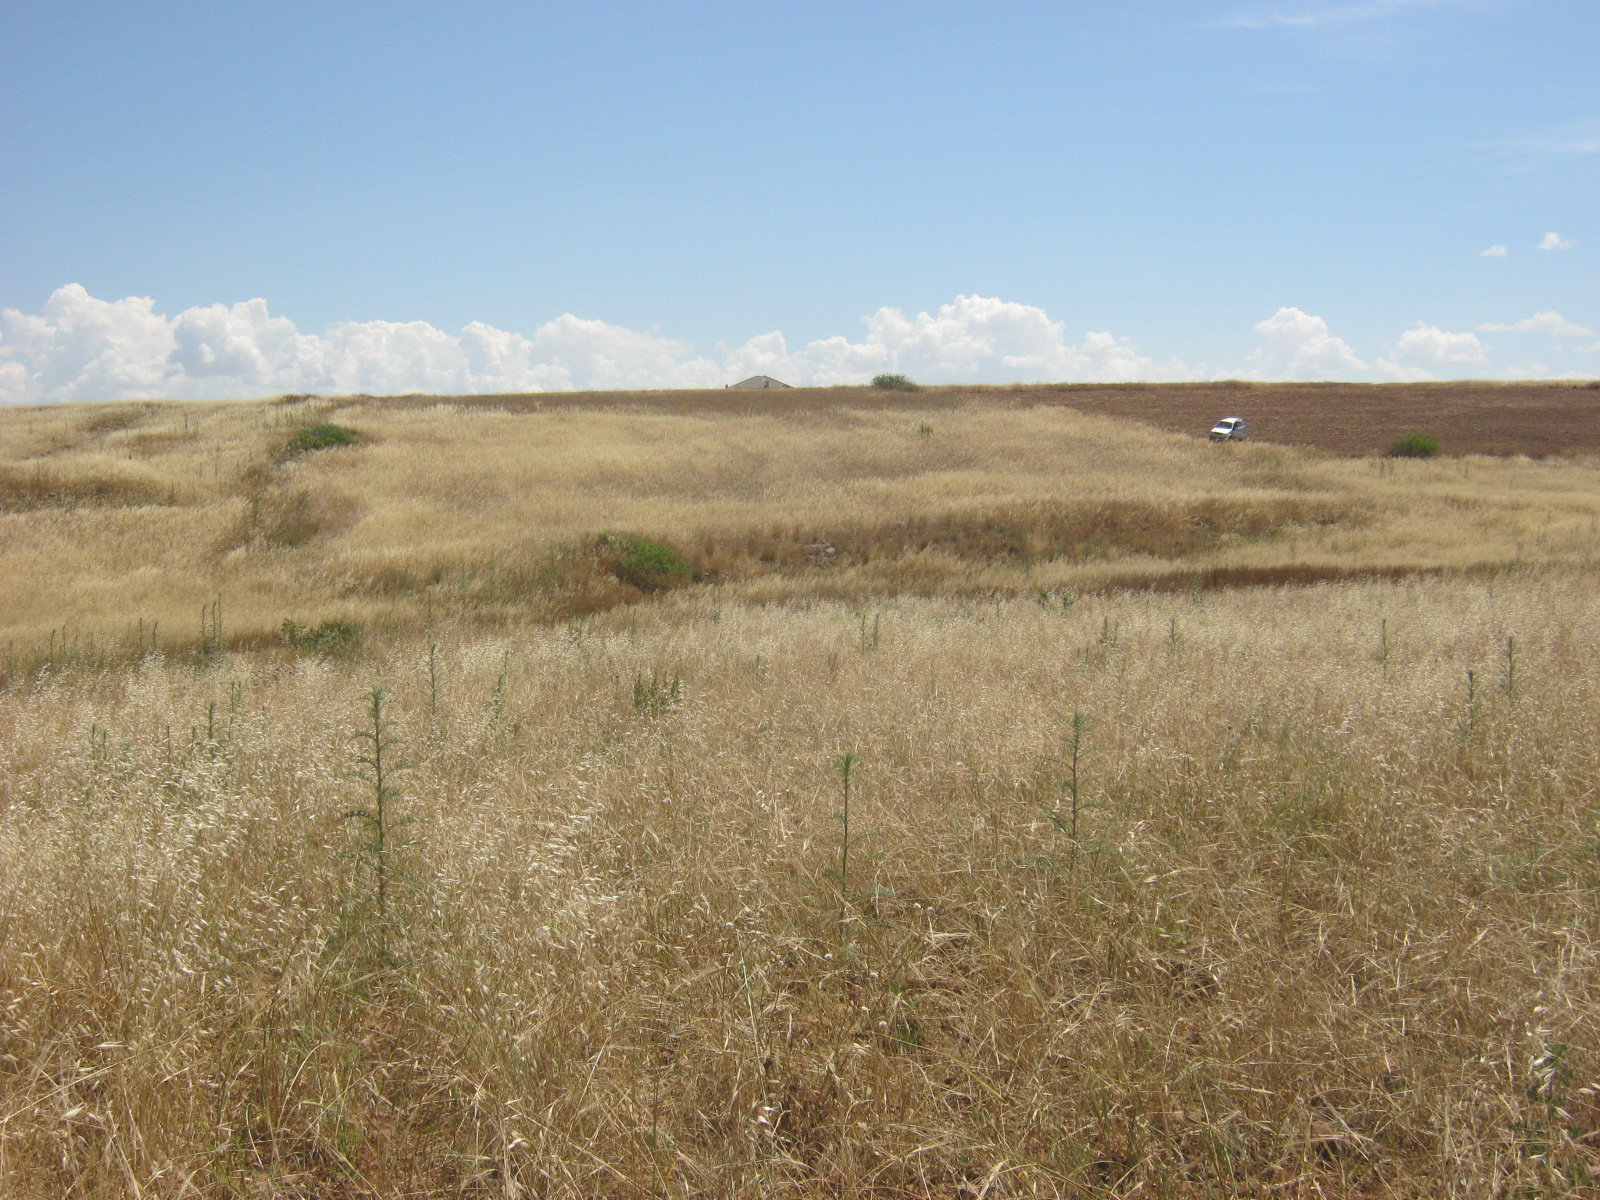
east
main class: Grassland
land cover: Spontaneously vegetated surfaces
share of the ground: > 75 %
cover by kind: herbaceous plants 100 %
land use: Semi-natural and natural areas not in use
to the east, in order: Spontaneously vegetated surfaces; Rivers and streams; Spontaneously vegetated surfaces; Common wheat
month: May
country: CY
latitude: 35.1103
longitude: 33.0096
